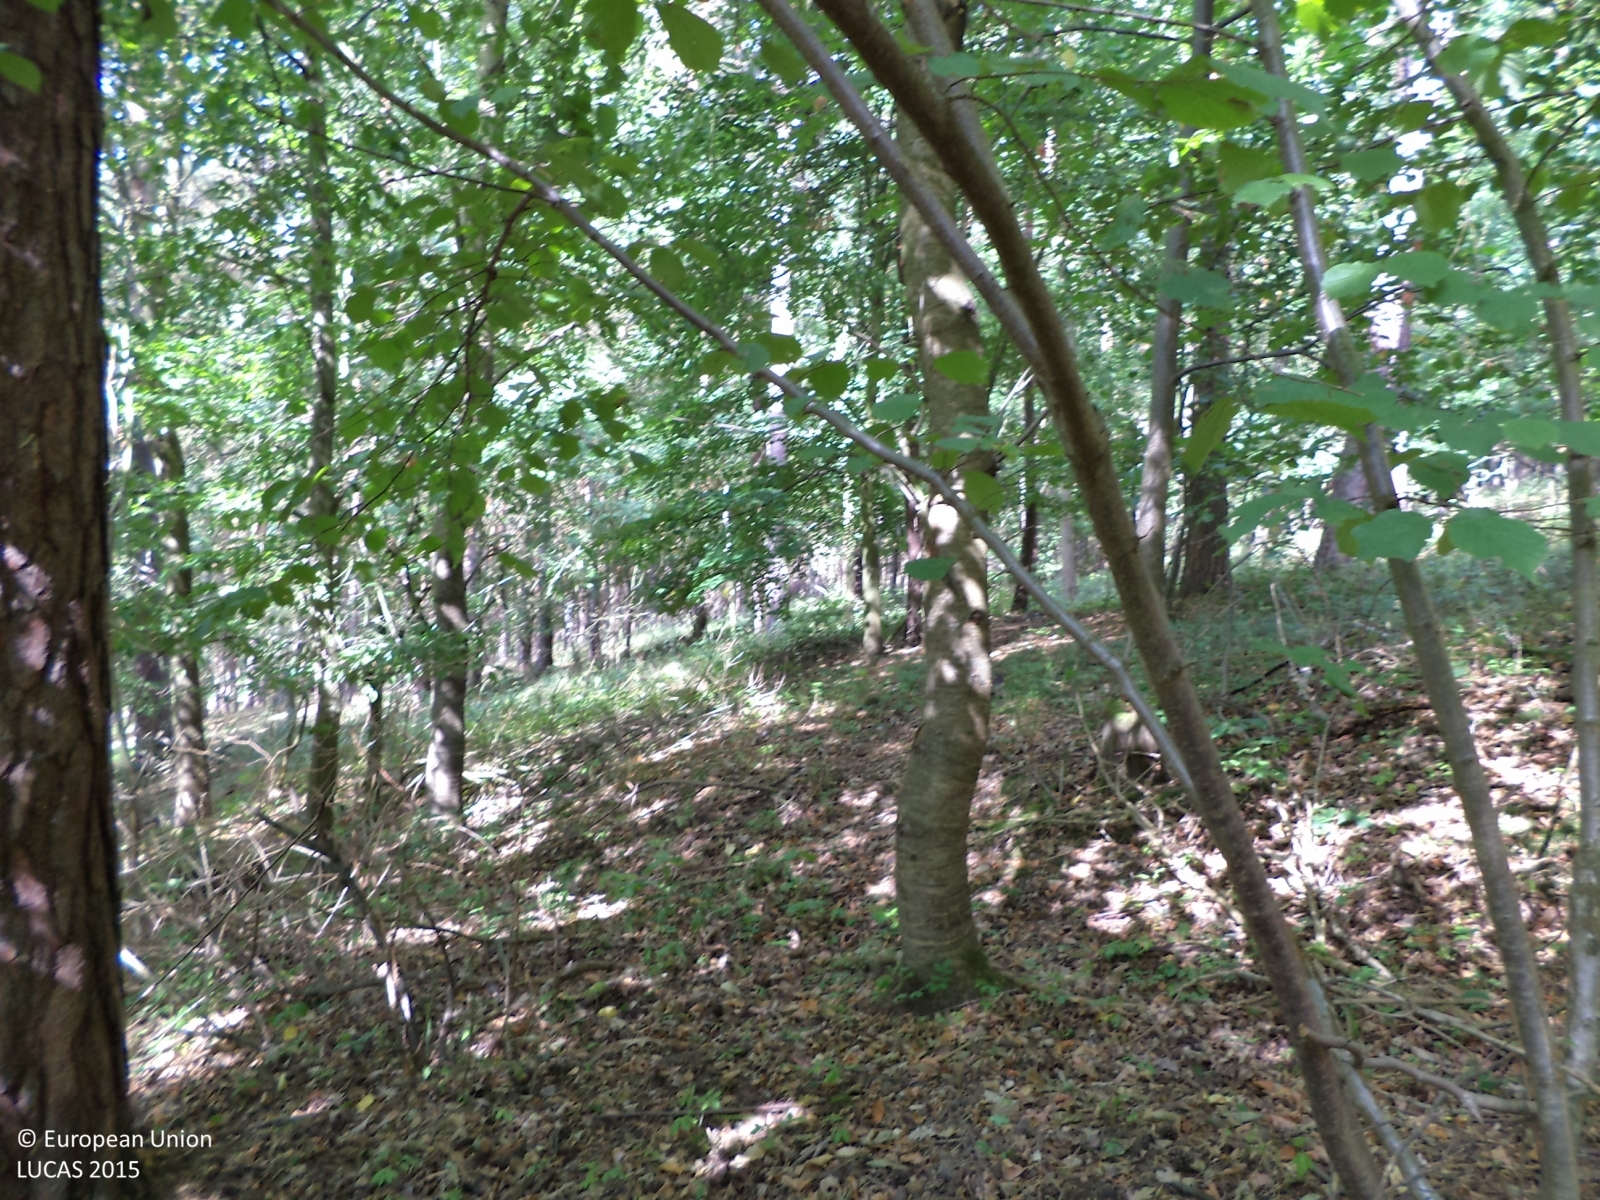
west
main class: Woodland
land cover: Pine dominated mixed woodland
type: hemiboreal forest and nemoral coniferous forest and mixed broadleaved-coniferous forest
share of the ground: > 75 %
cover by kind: coniferous forest trees 60 %, broadleaved forest trees 40 %
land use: Forestry
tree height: > 5 m
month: July
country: CZ
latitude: 49.7180
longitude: 14.4815
